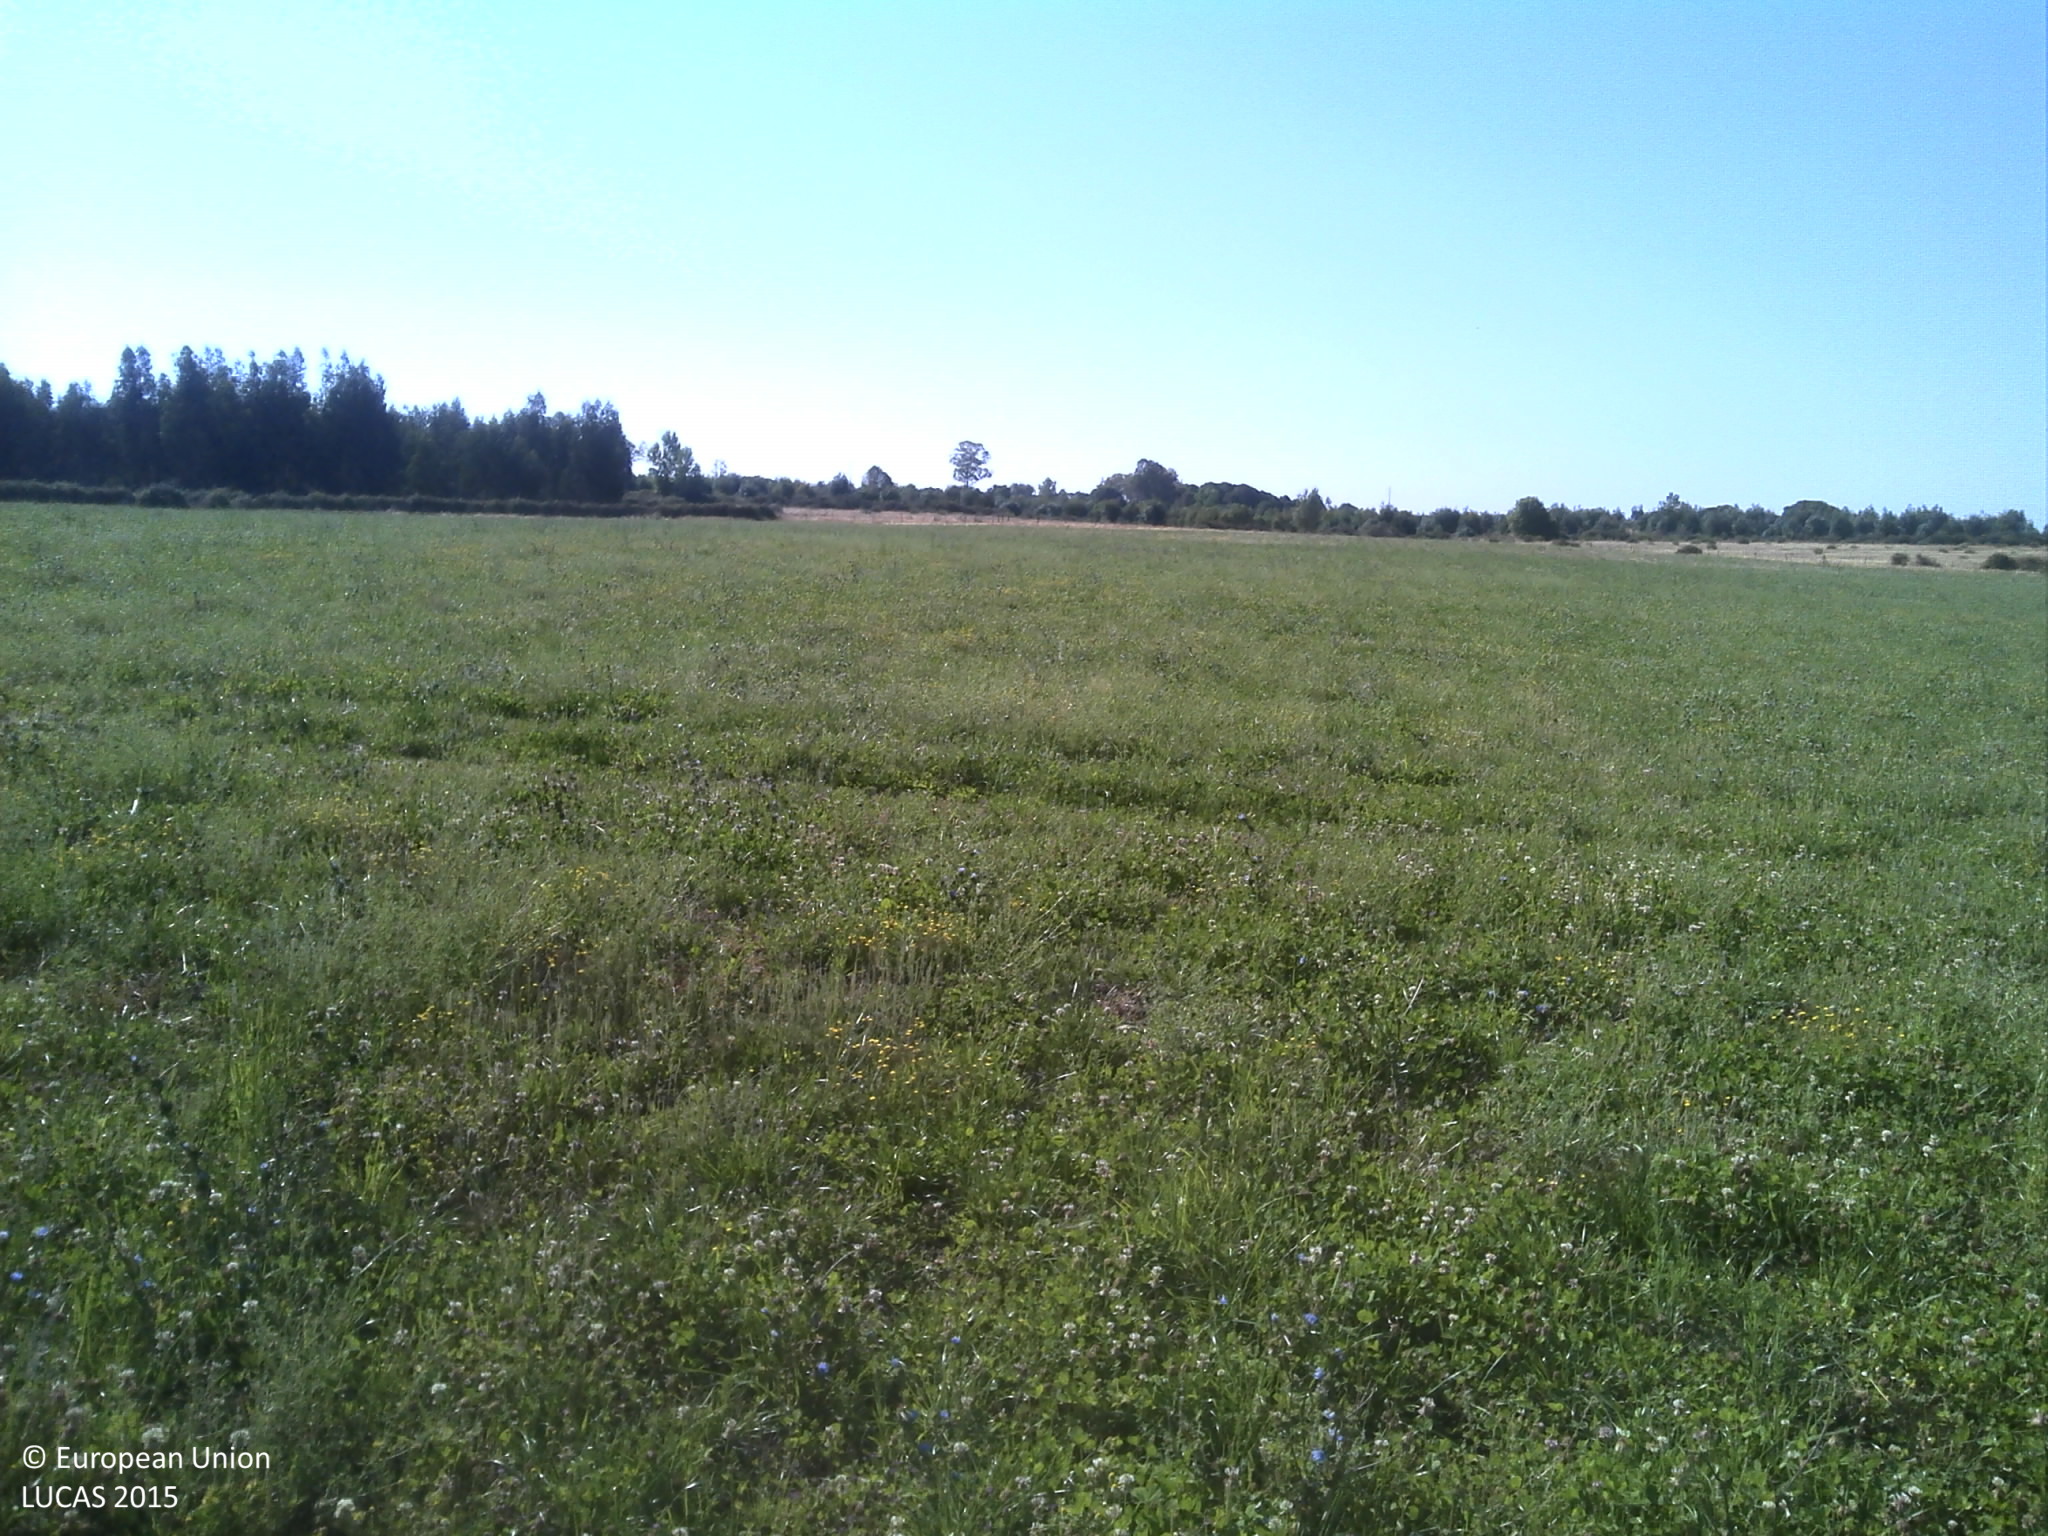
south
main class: Cropland
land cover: Temporary grasslands
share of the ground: > 75 %
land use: Agriculture (excluding fallow land and kitchen gardens)
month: June
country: PT
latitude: 39.8887
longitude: -7.2499
